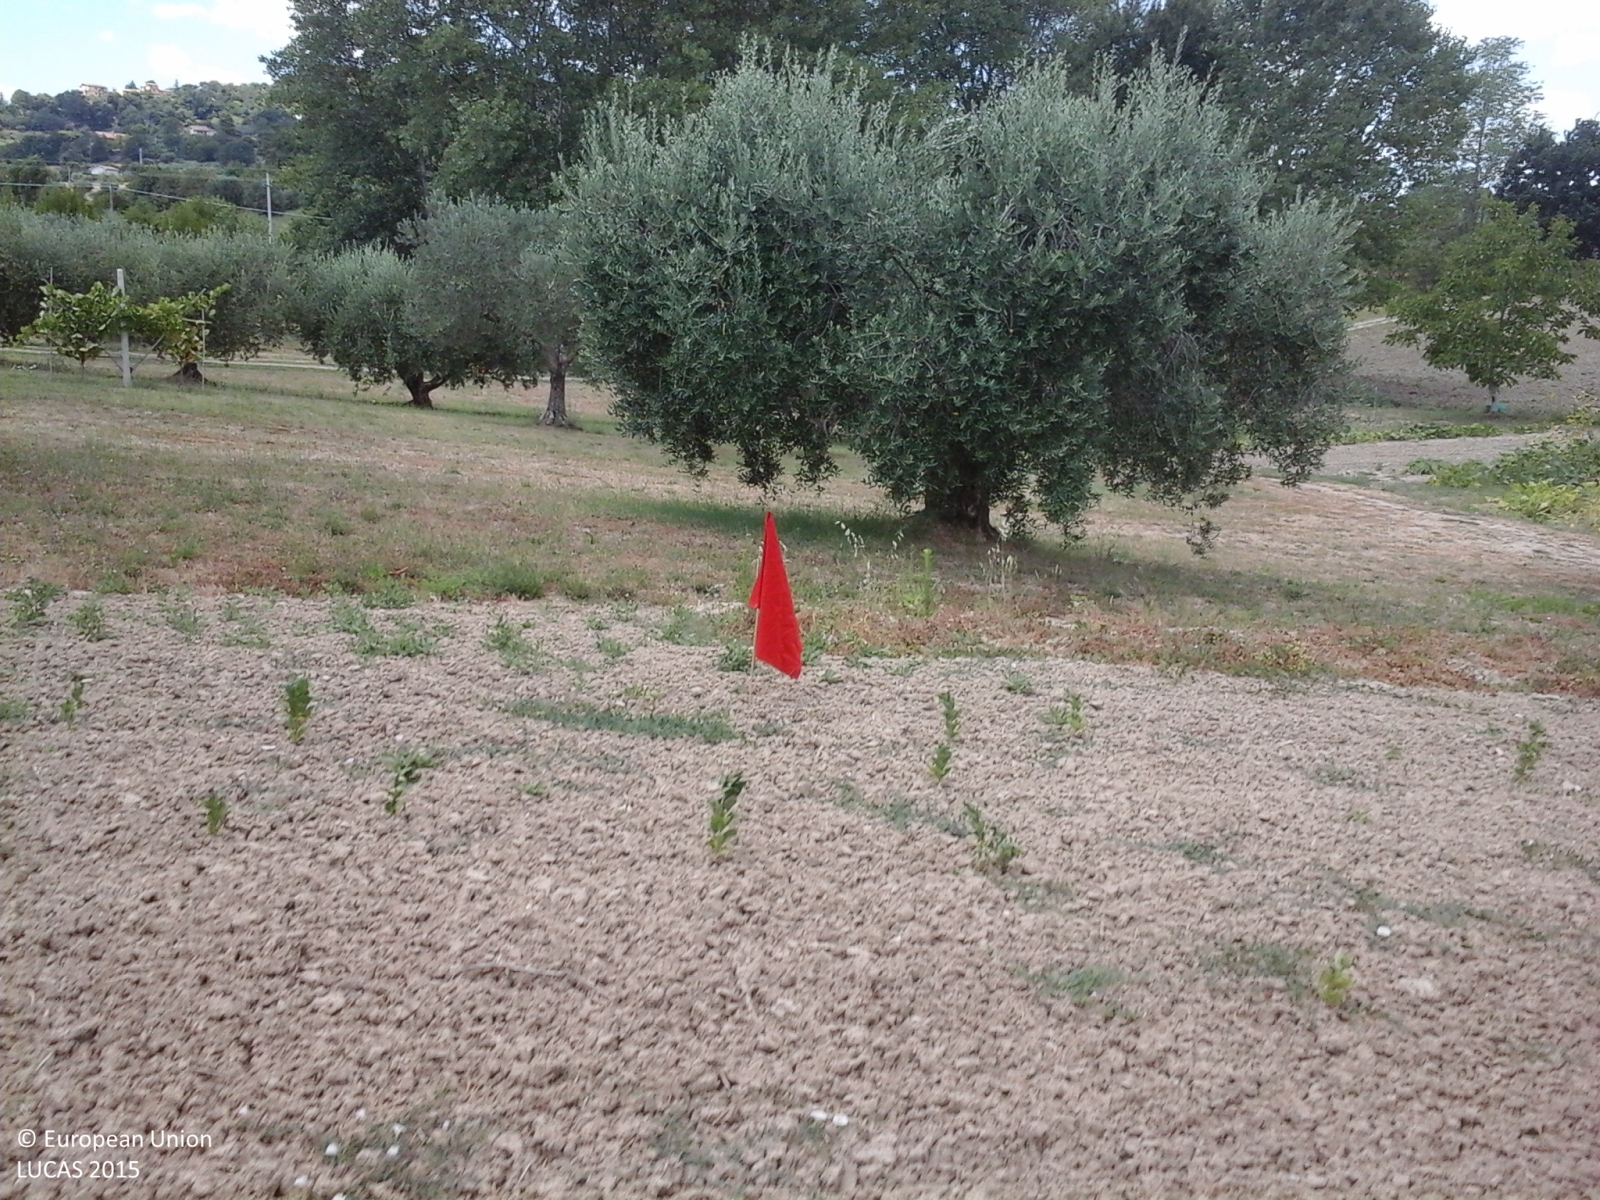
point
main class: Cropland
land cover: Olive groves
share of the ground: > 75 %
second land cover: Other bare soil
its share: > 75 %
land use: Agriculture (excluding fallow land and kitchen gardens)
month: July
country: IT
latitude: 43.3039
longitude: 13.3322
